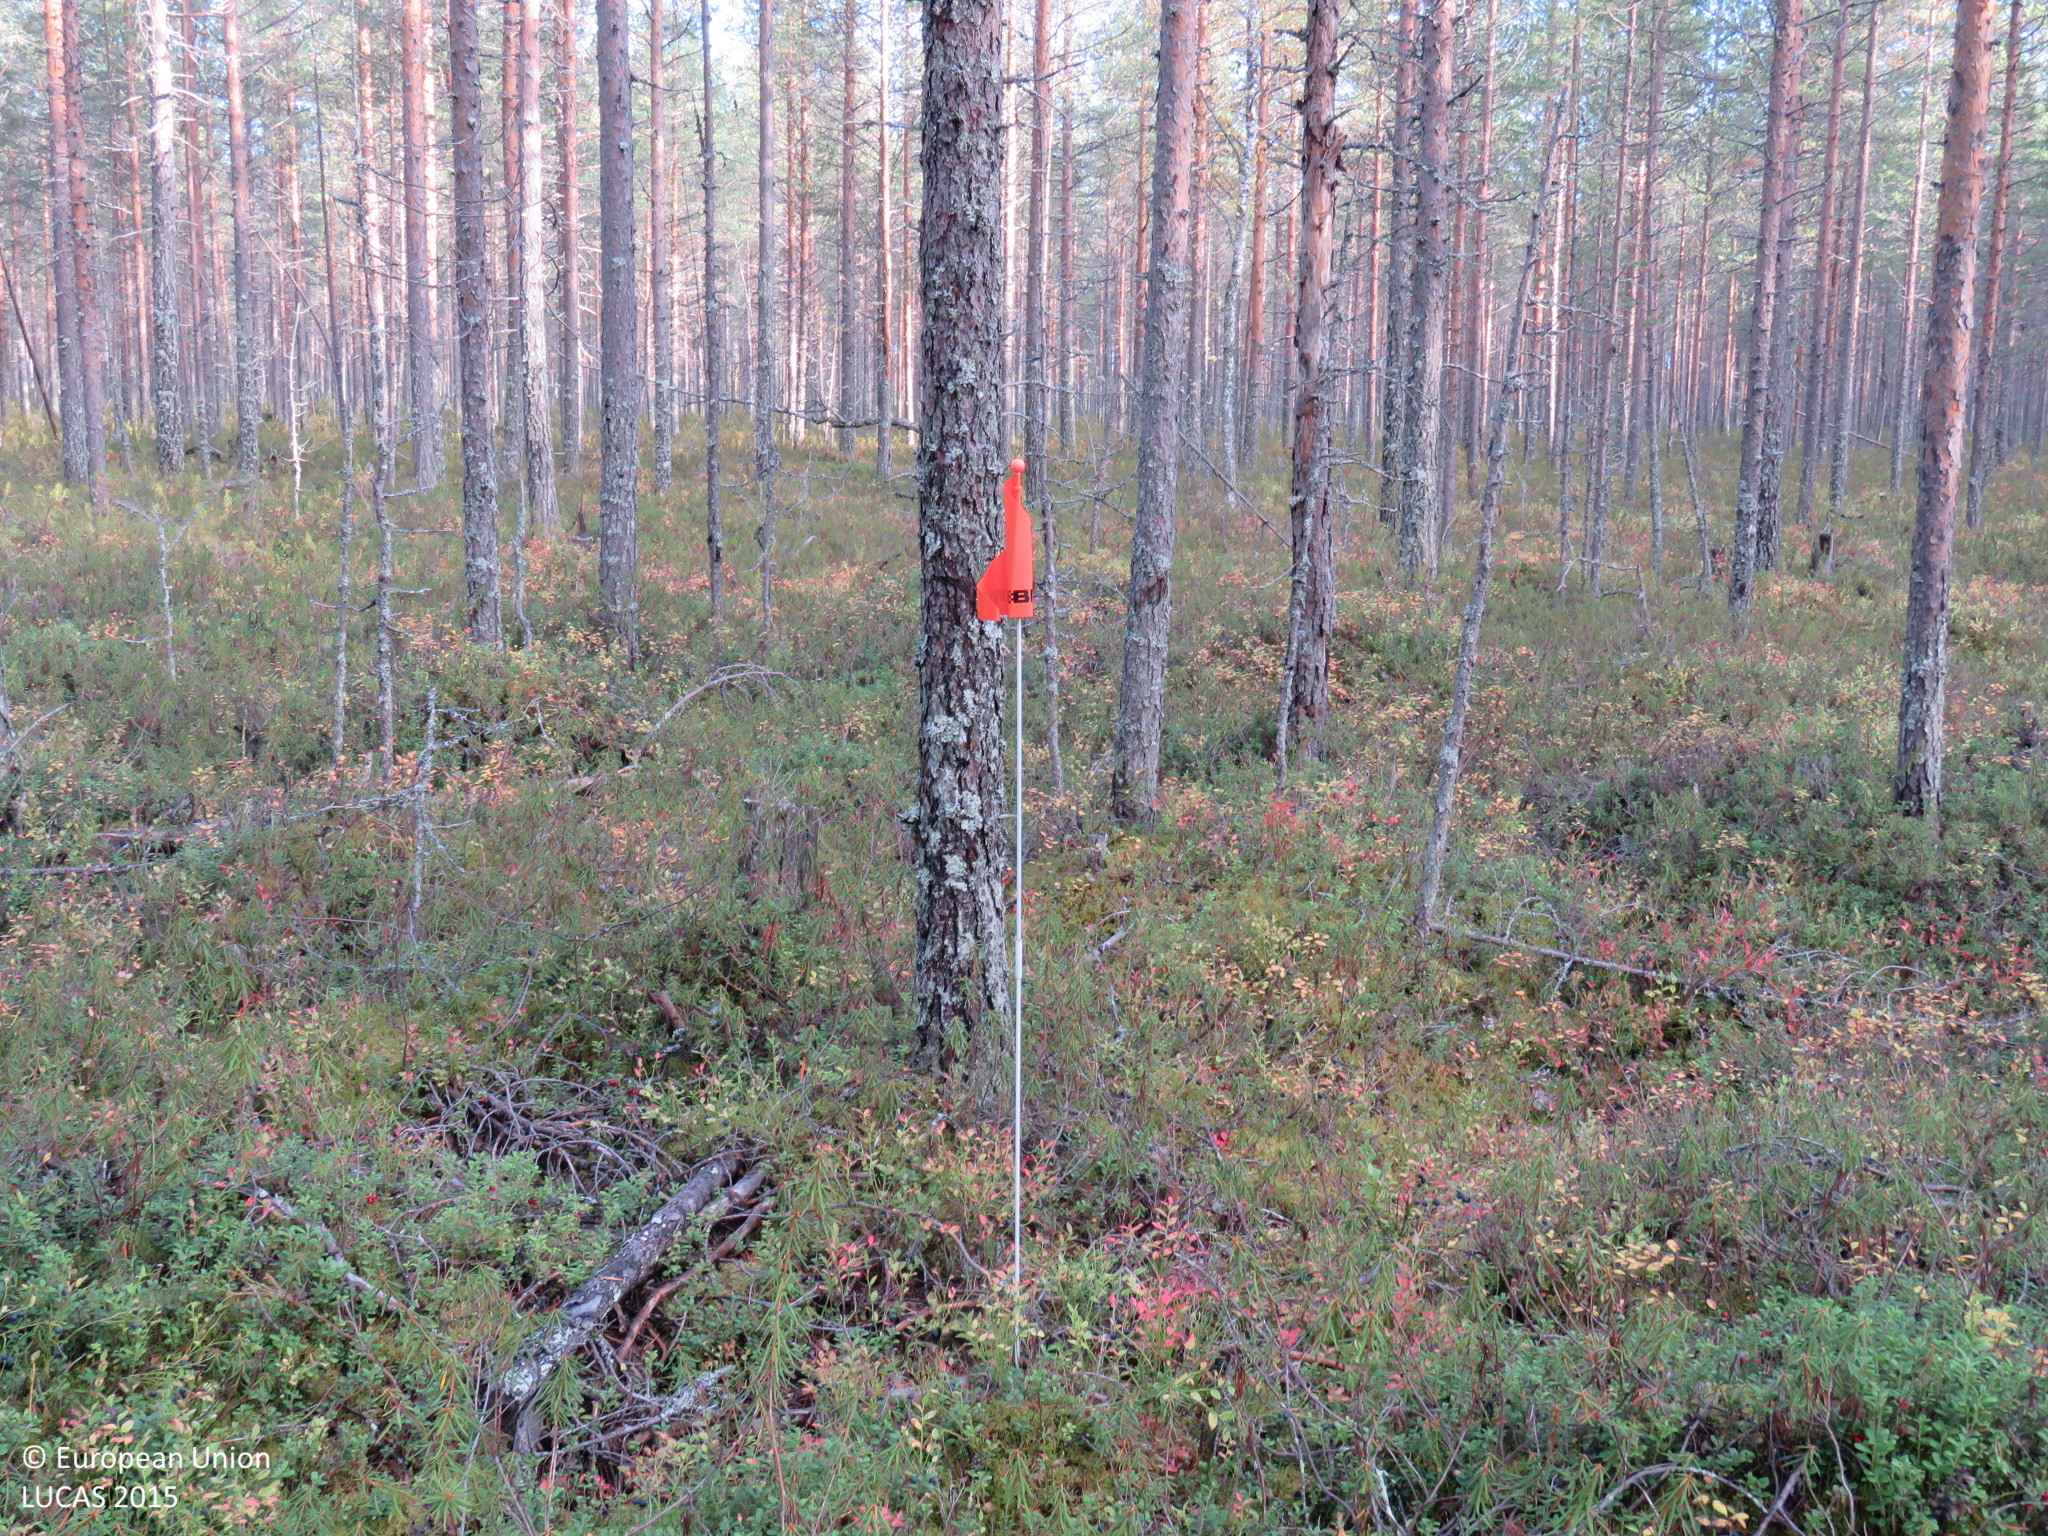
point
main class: Woodland
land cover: Pine dominated coniferous woodland
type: boreal forest
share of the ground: 50 - 75 %
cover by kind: coniferous forest trees 70 %, shrubs 20 %, lichens and mosses 10 %
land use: Forestry
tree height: > 5 m
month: September
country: FI
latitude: 65.1096
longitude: 26.9626
